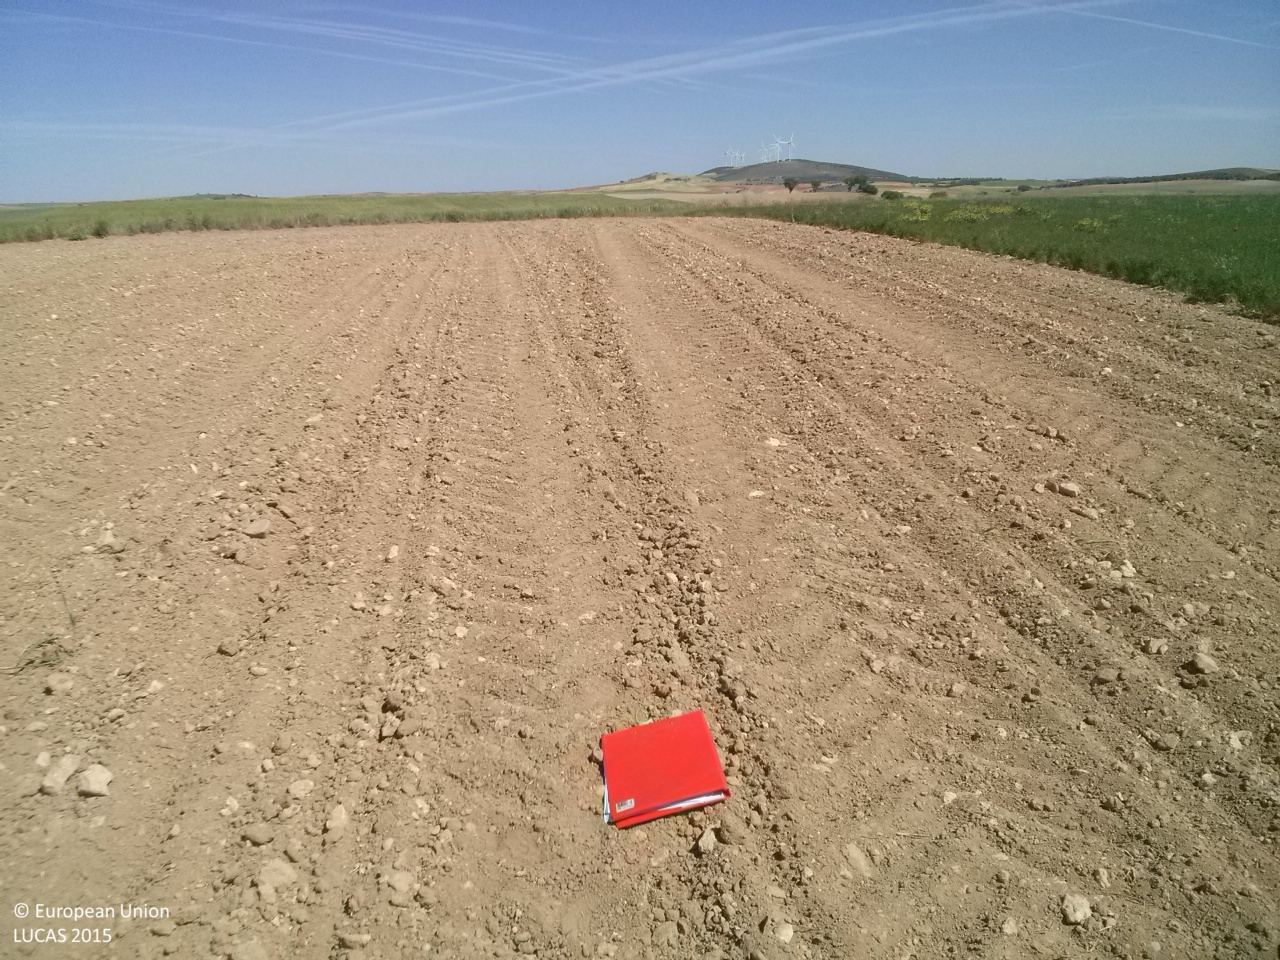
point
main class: Cropland
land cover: Sunflower
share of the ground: < 10 %
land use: Agriculture (excluding fallow land and kitchen gardens)
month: May
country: ES
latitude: 39.9450
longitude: -2.7423
